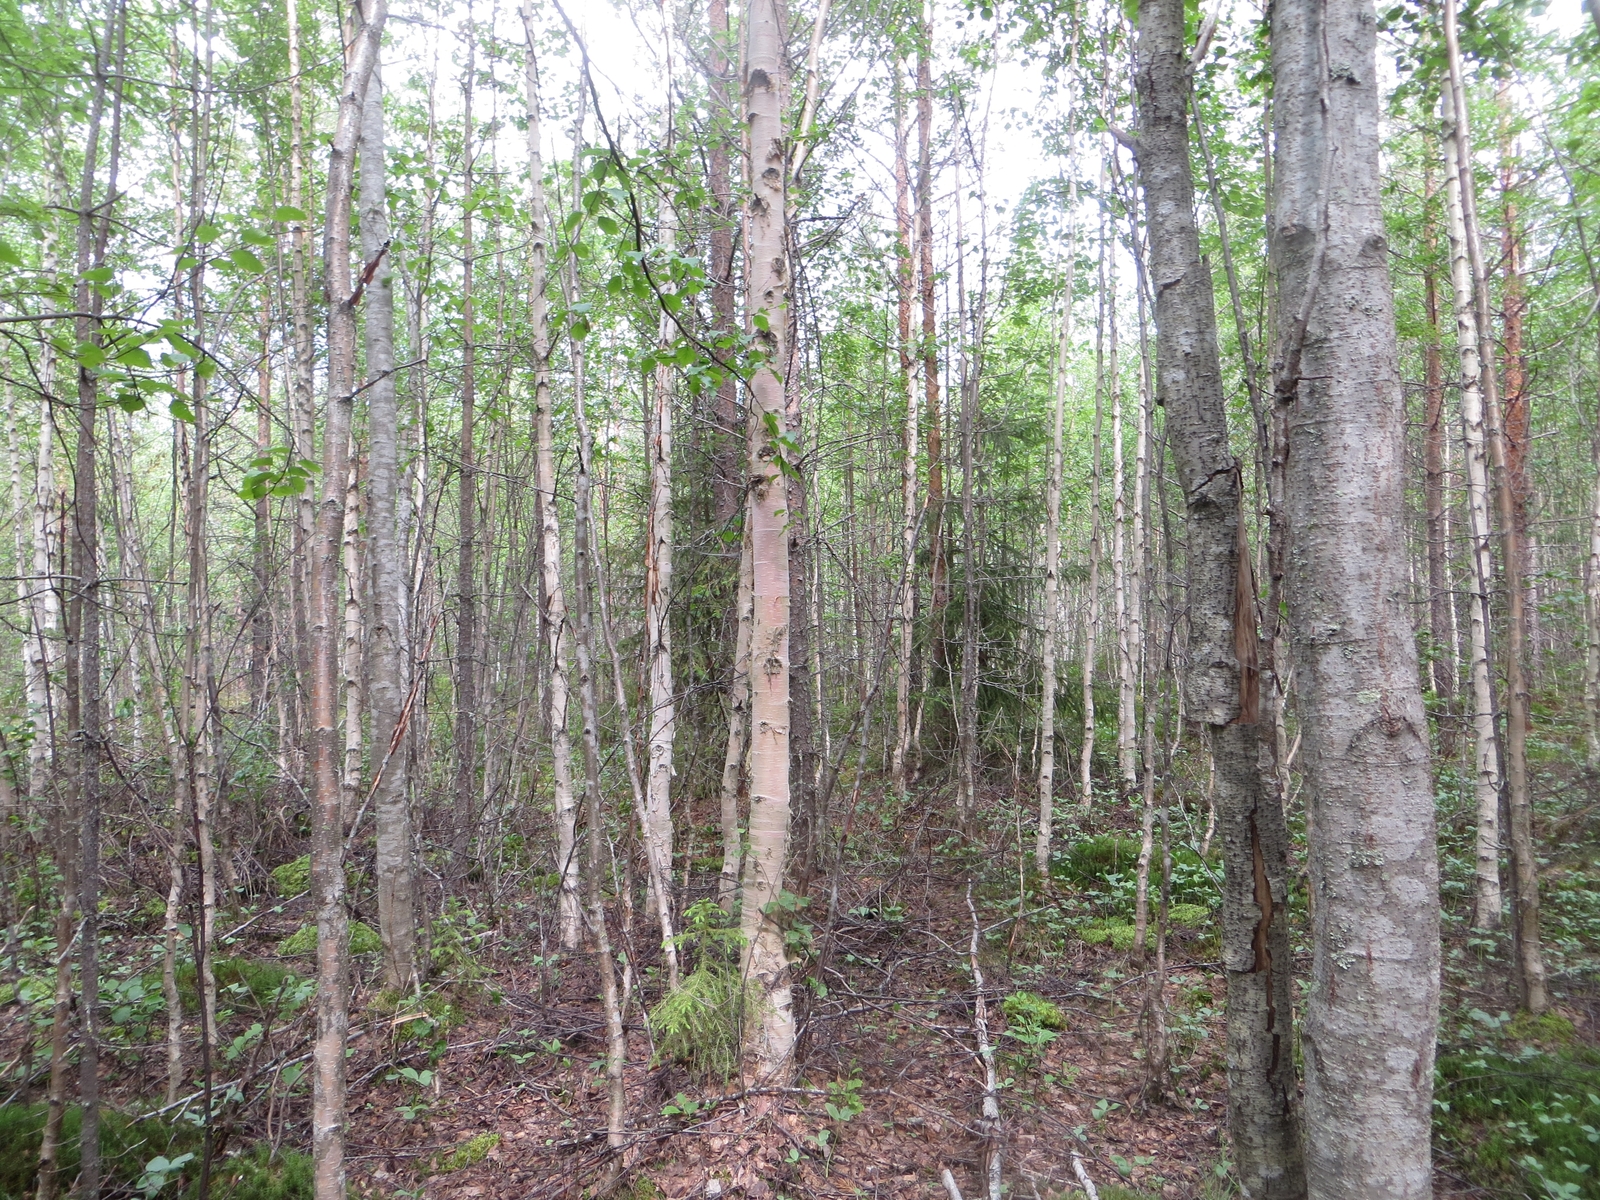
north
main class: Woodland
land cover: Pine dominated mixed woodland
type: boreal forest
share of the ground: > 75 %
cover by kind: broadleaved forest trees 50 %, coniferous forest trees 35 %, shrubs 15 %
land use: Forestry
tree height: > 5 m
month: July
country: FI
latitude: 65.4283
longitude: 25.8407
